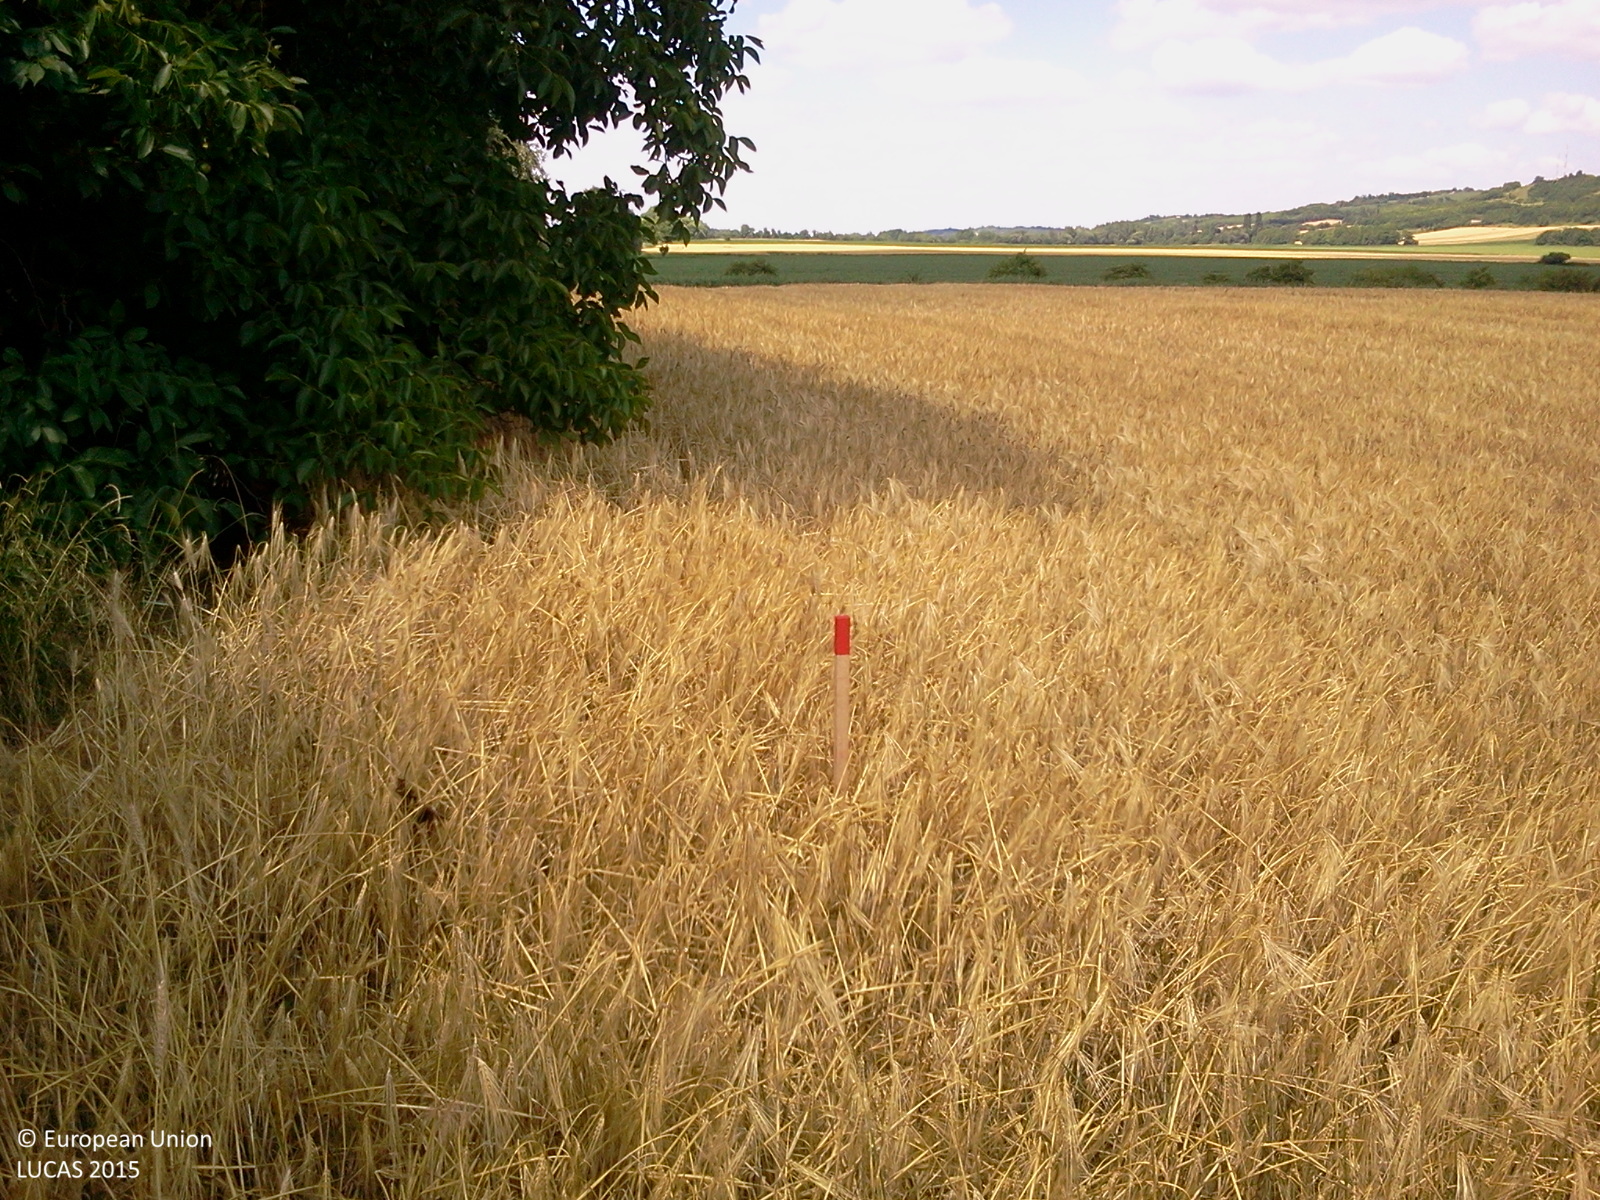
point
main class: Cropland
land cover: Barley
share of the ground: > 75 %
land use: Agriculture (excluding fallow land and kitchen gardens)
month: June
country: HU
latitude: 46.9279
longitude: 17.1098
